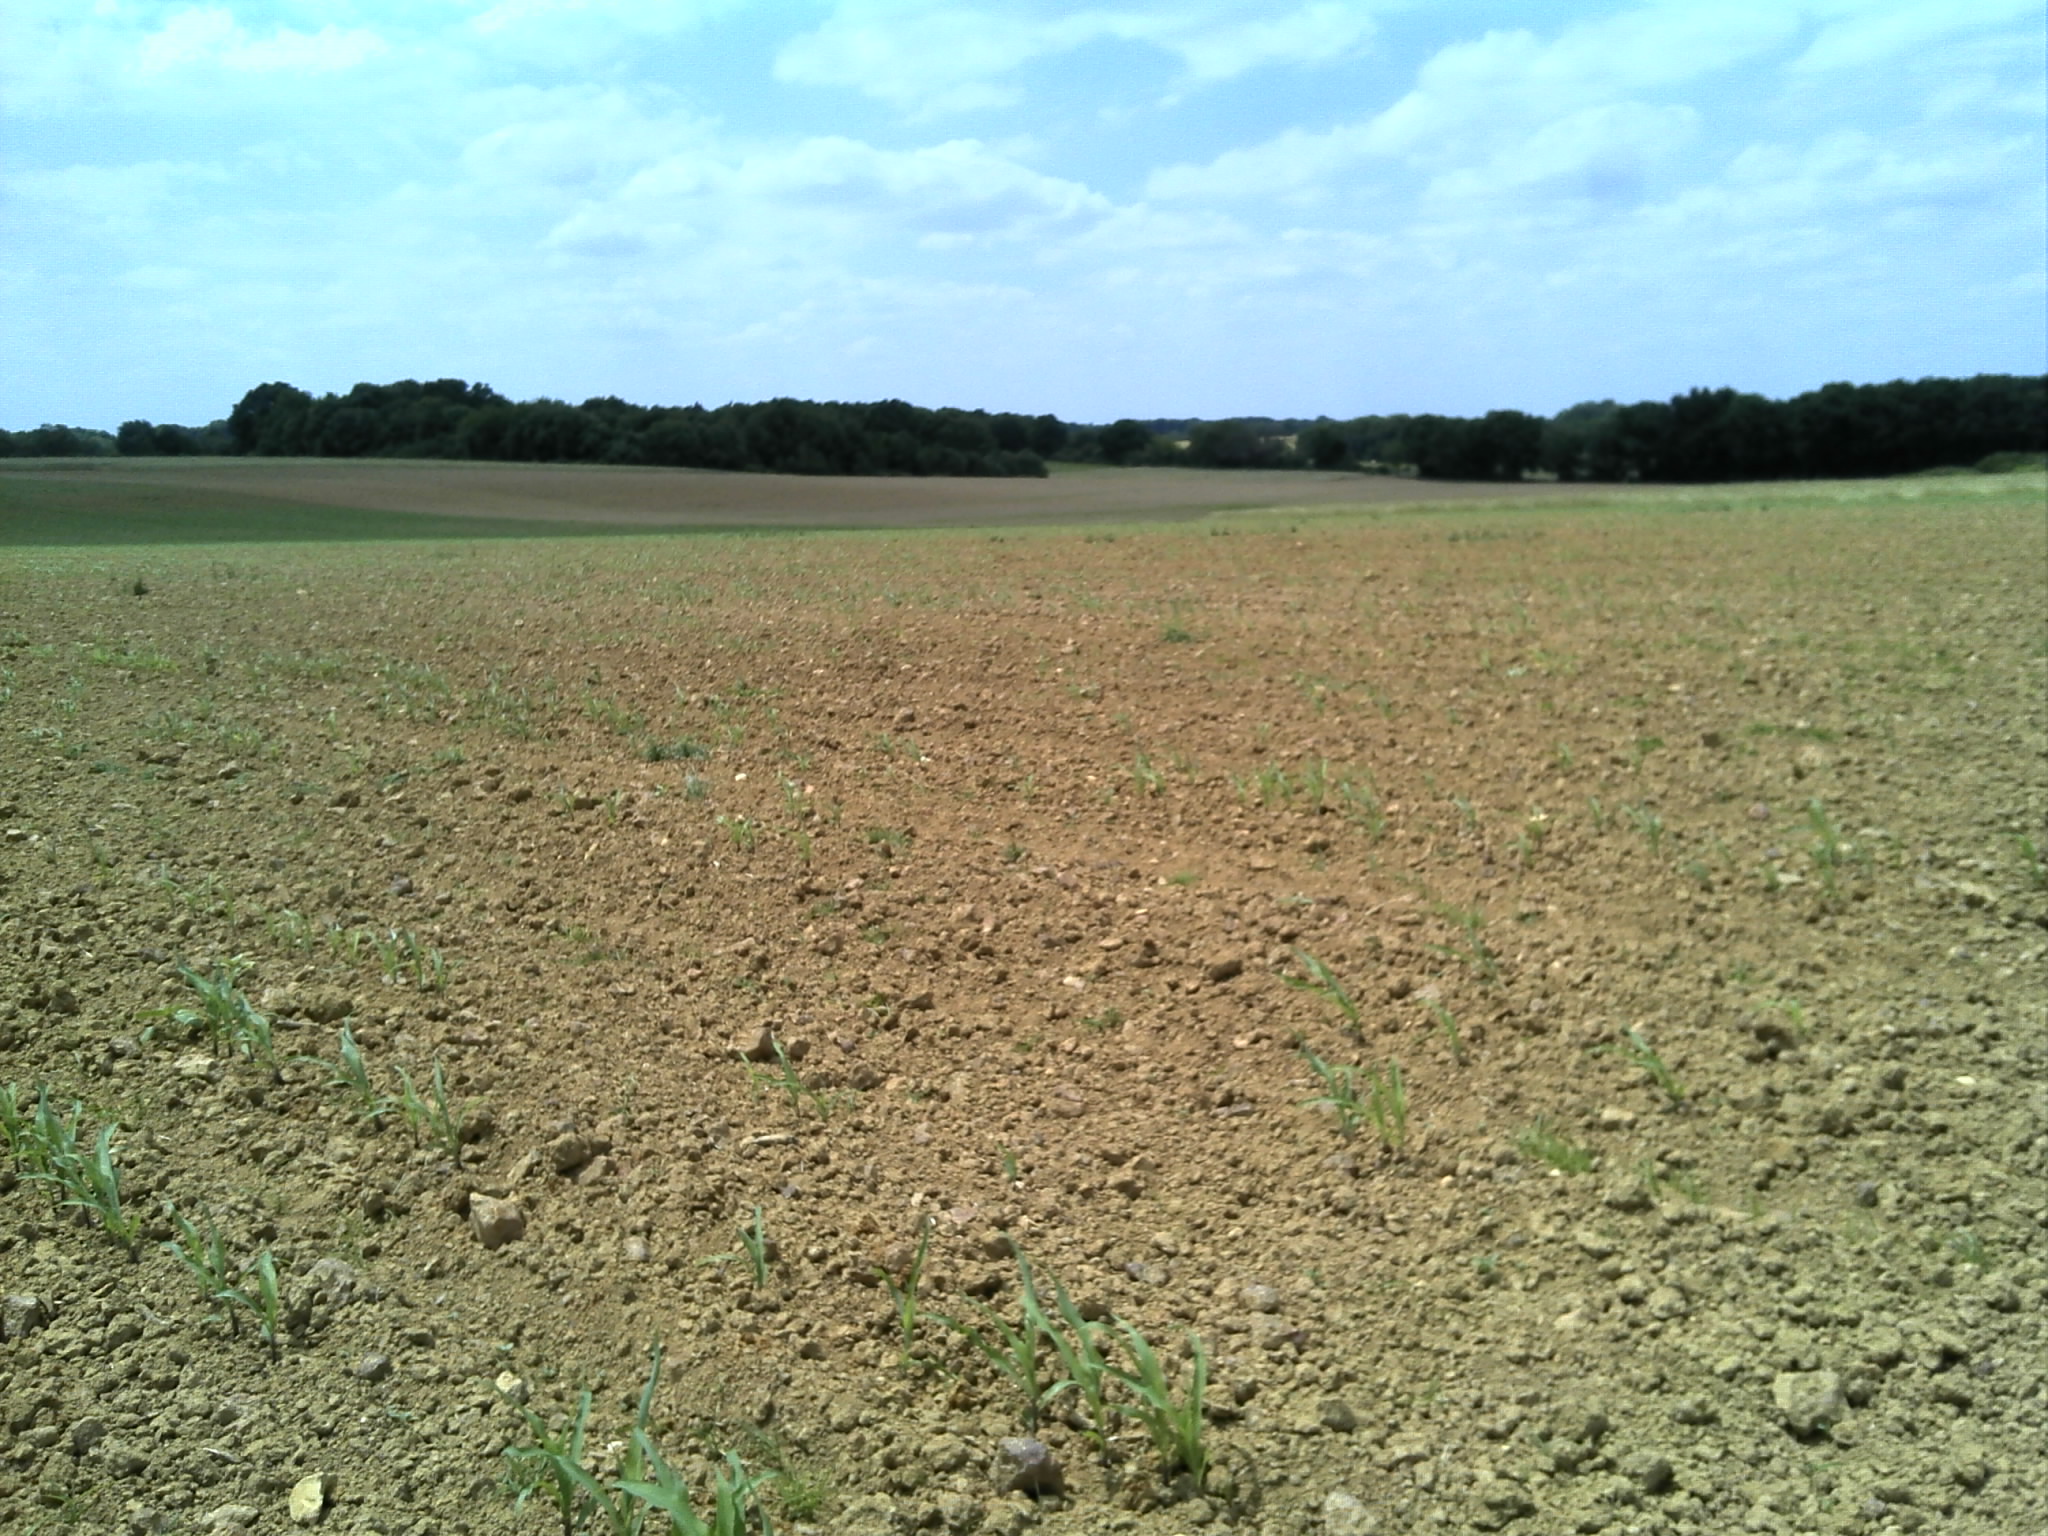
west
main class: Cropland
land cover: Maize
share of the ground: < 10 %
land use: Agriculture (excluding fallow land and kitchen gardens)
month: June
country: FR
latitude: 46.6001
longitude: 0.9390
